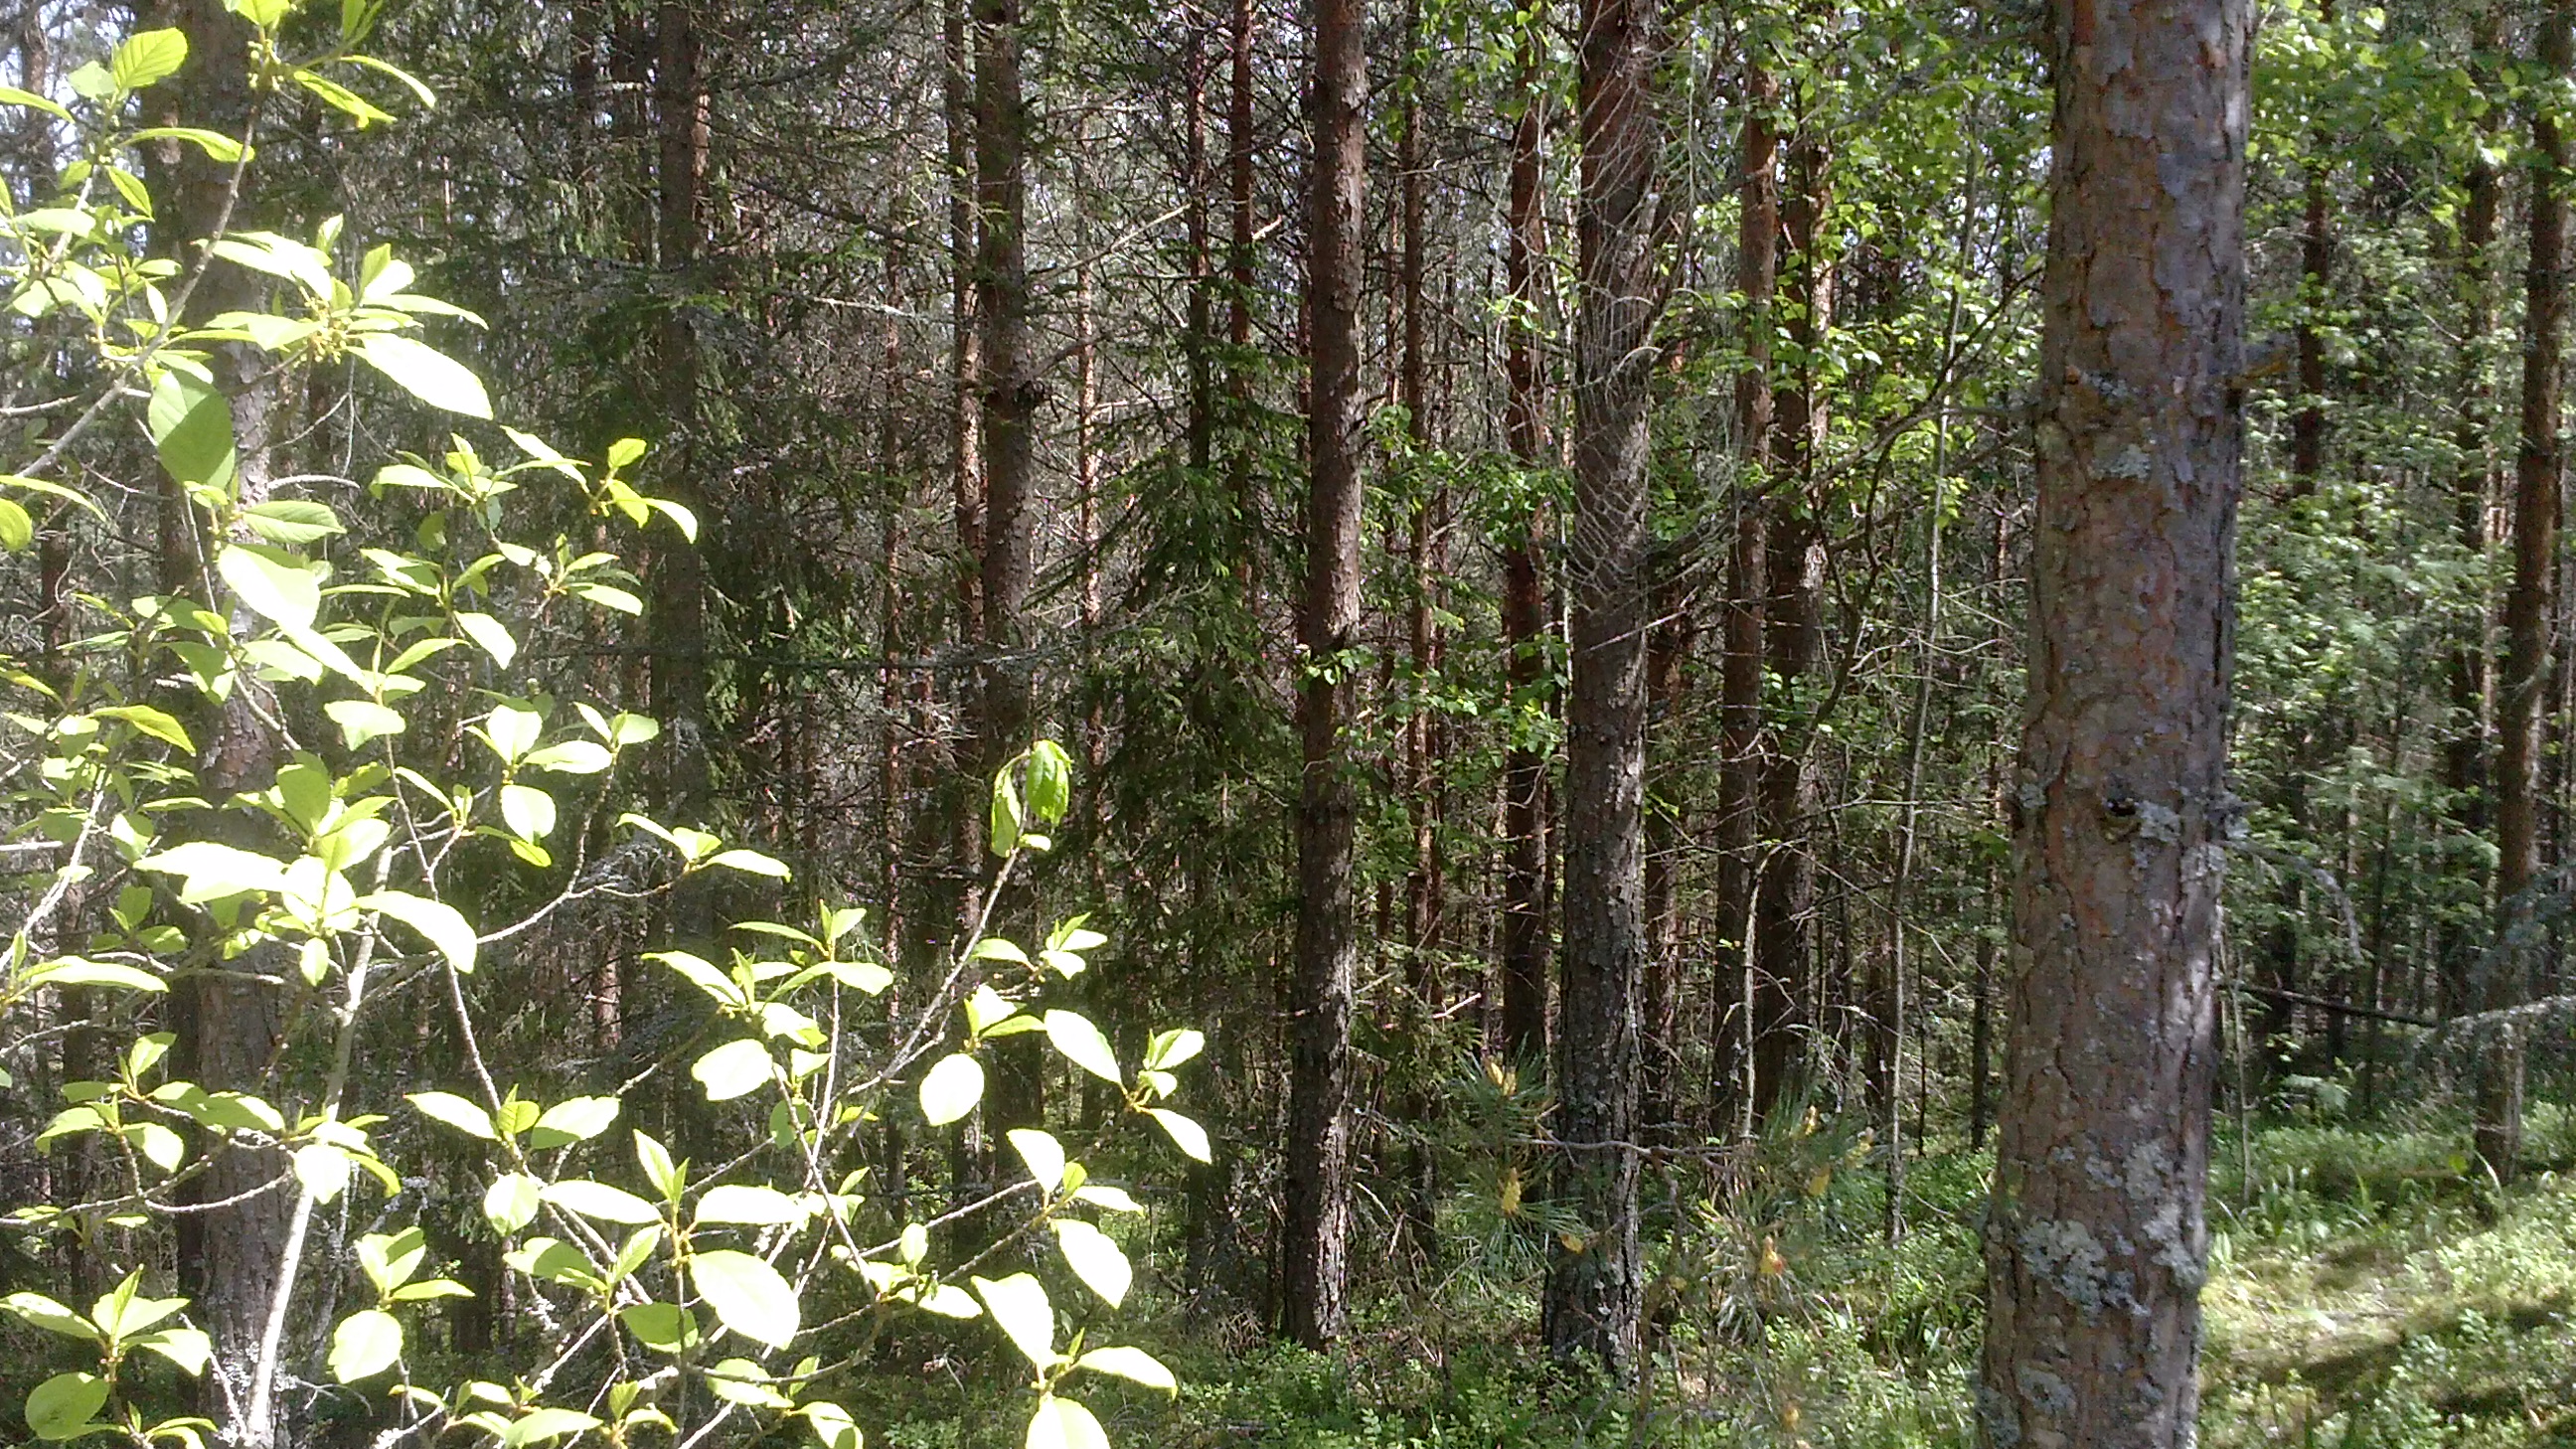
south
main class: Grassland
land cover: Spontaneously vegetated surfaces
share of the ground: > 75 %
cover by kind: herbaceous plants 75 %, unconsolidated bare surface 10 %, shrubs 5 %, lichens and mosses 5 %
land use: Forestry
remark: Clear cut
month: May
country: LV
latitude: 56.2965
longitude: 27.2520
